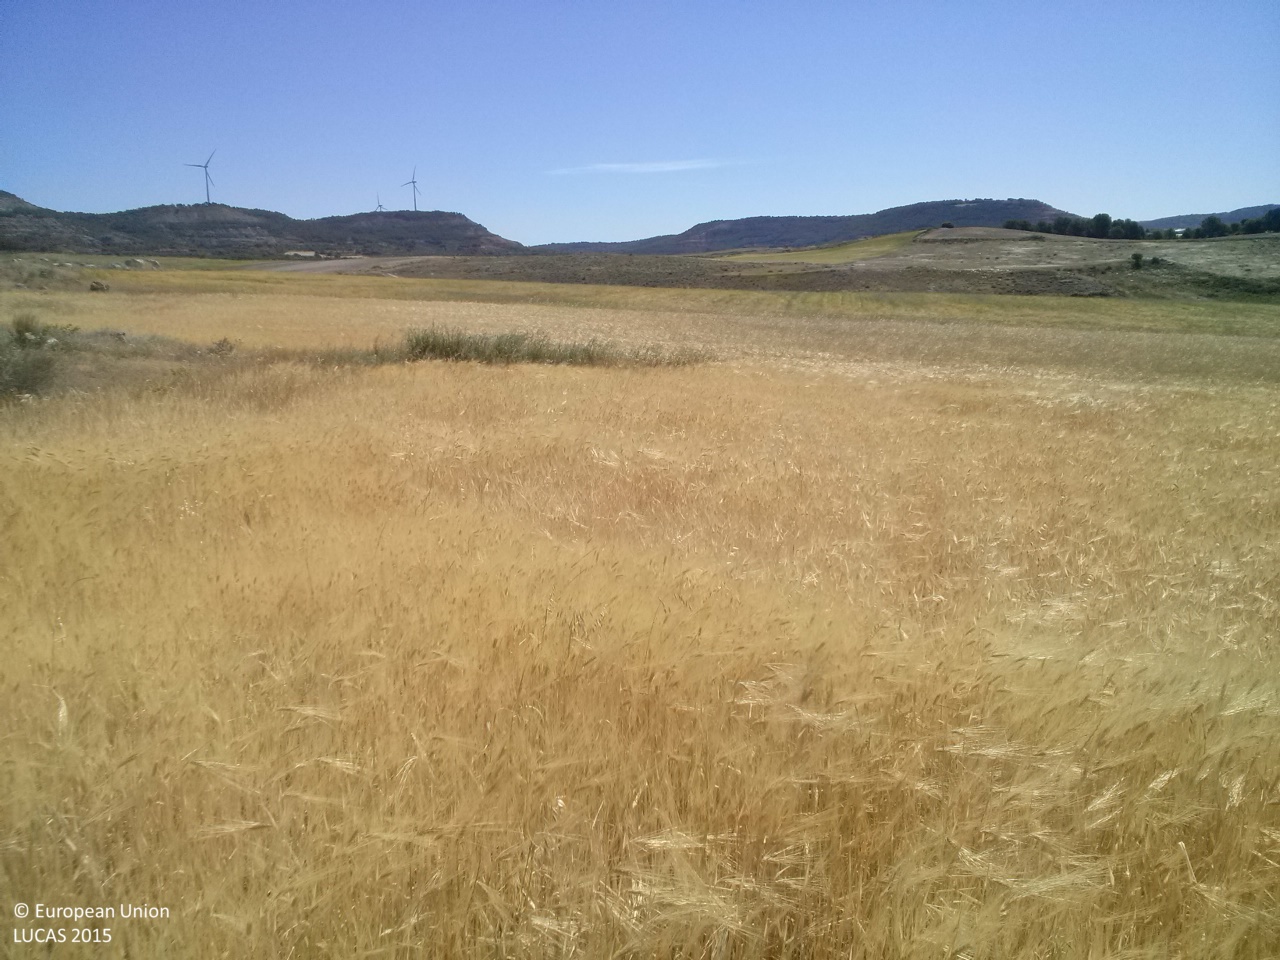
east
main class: Cropland
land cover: Barley
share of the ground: > 75 %
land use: Agriculture (excluding fallow land and kitchen gardens)
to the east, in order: Barley
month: May
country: ES
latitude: 40.3285
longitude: -2.6054
